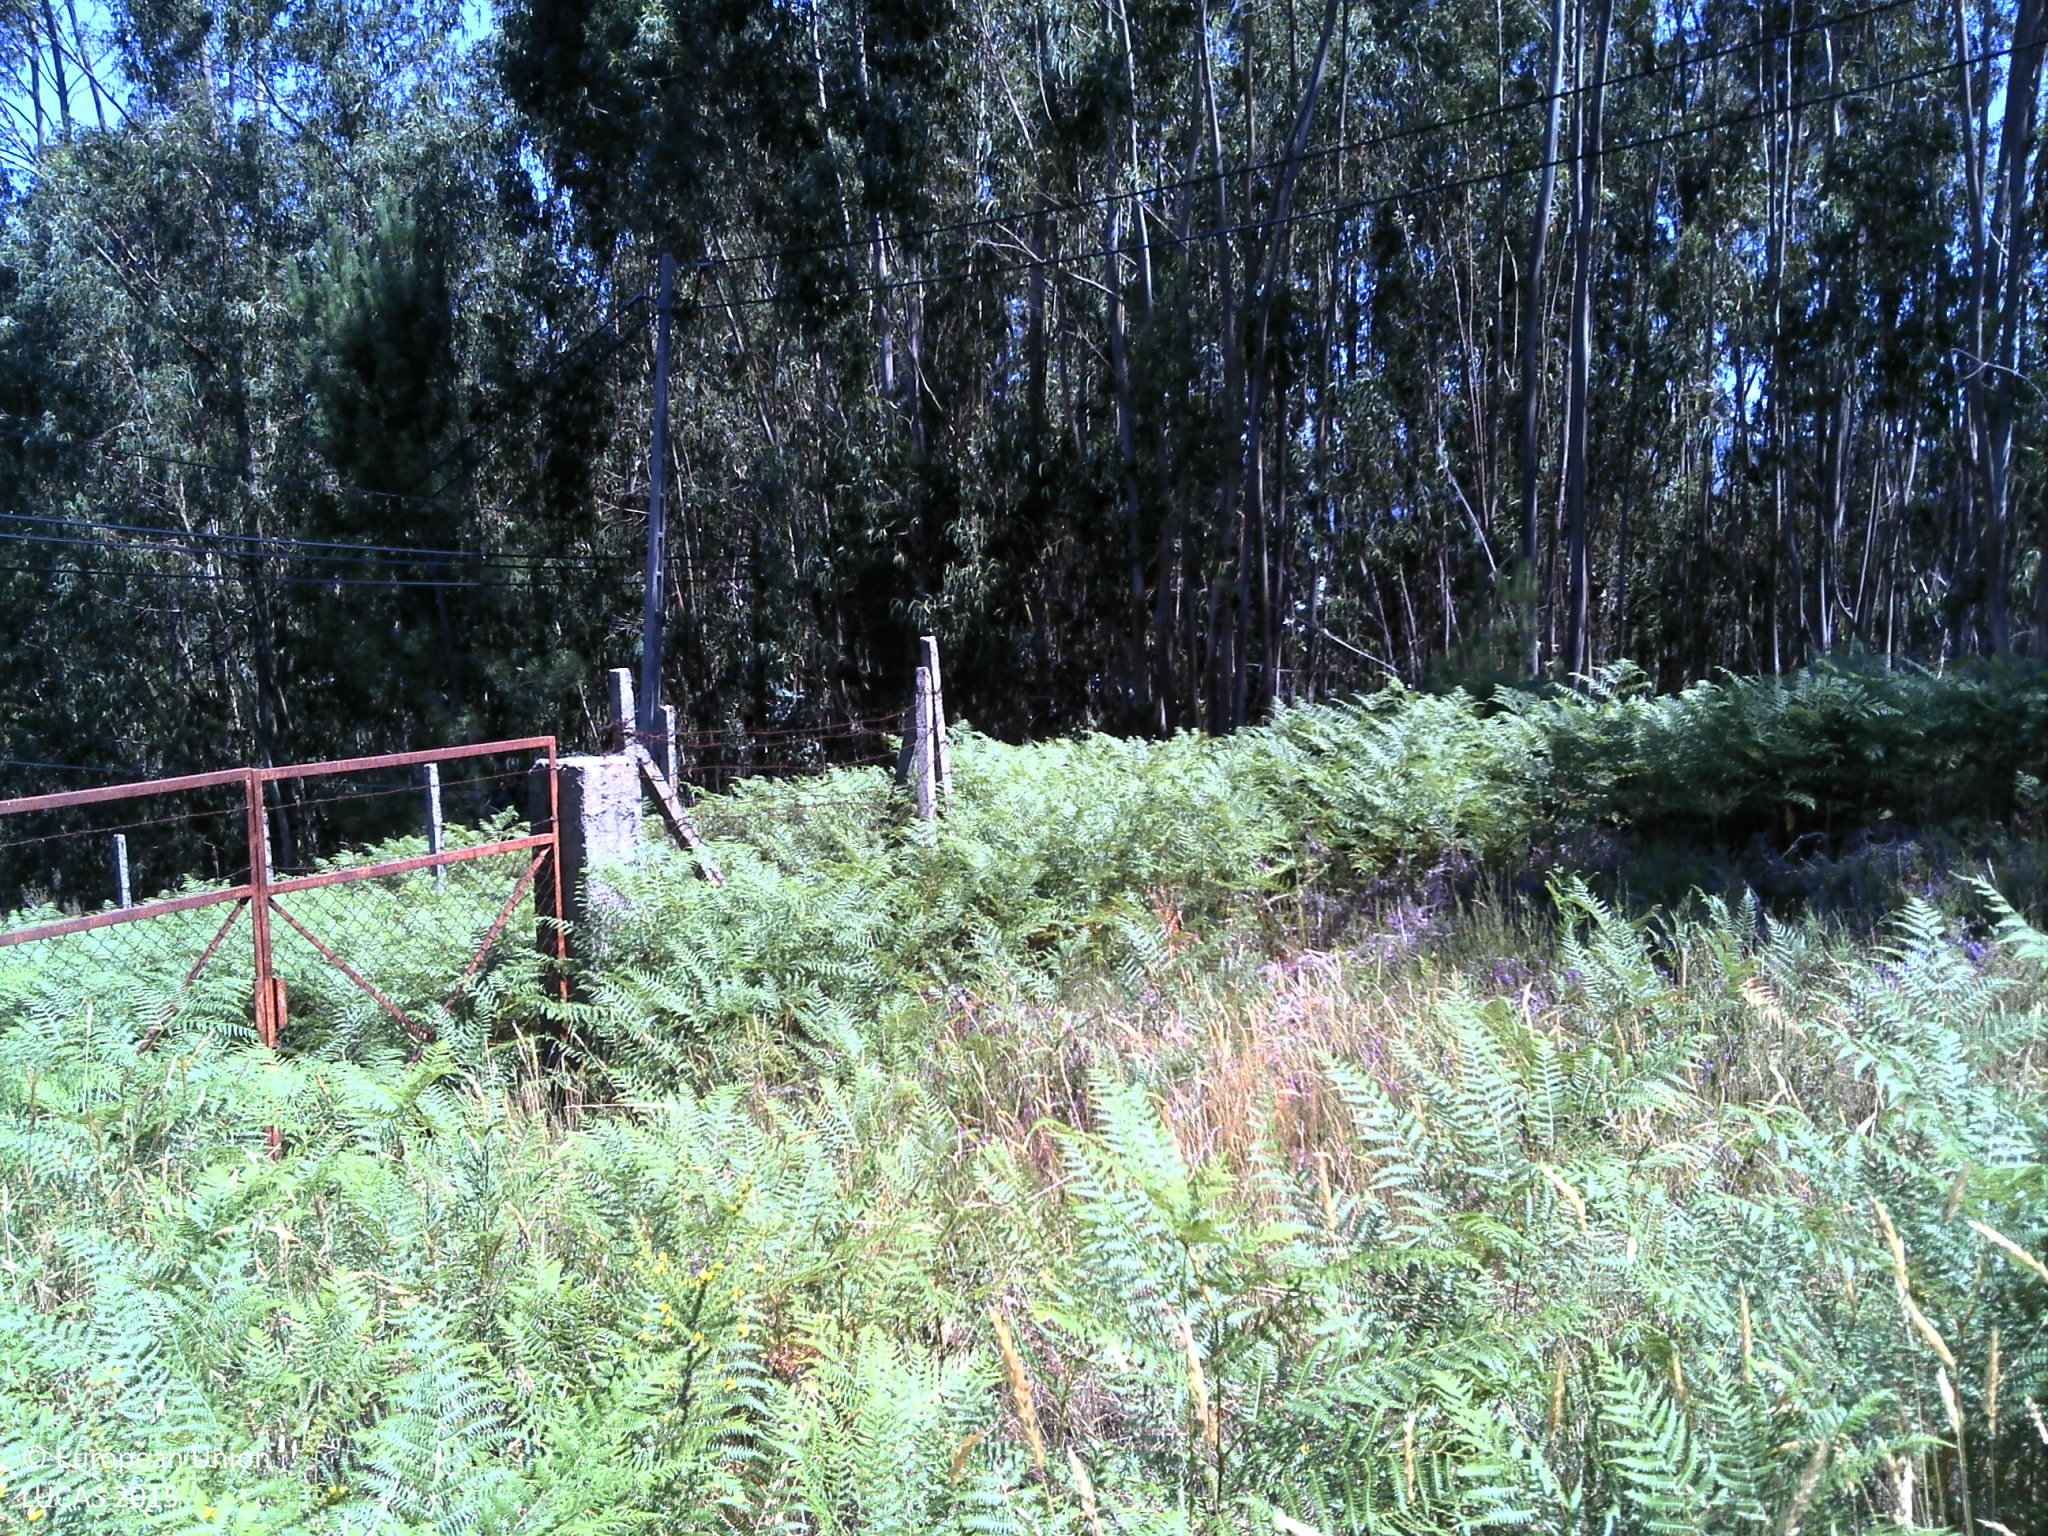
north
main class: Shrubland
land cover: Shrubland with sparse tree cover
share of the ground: > 75 %
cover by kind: shrubs 90 %, broadleaved forest trees 5 %, unconsolidated bare surface 5 %
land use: Abandoned areas
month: July
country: PT
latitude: 39.9881
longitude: -8.2144
